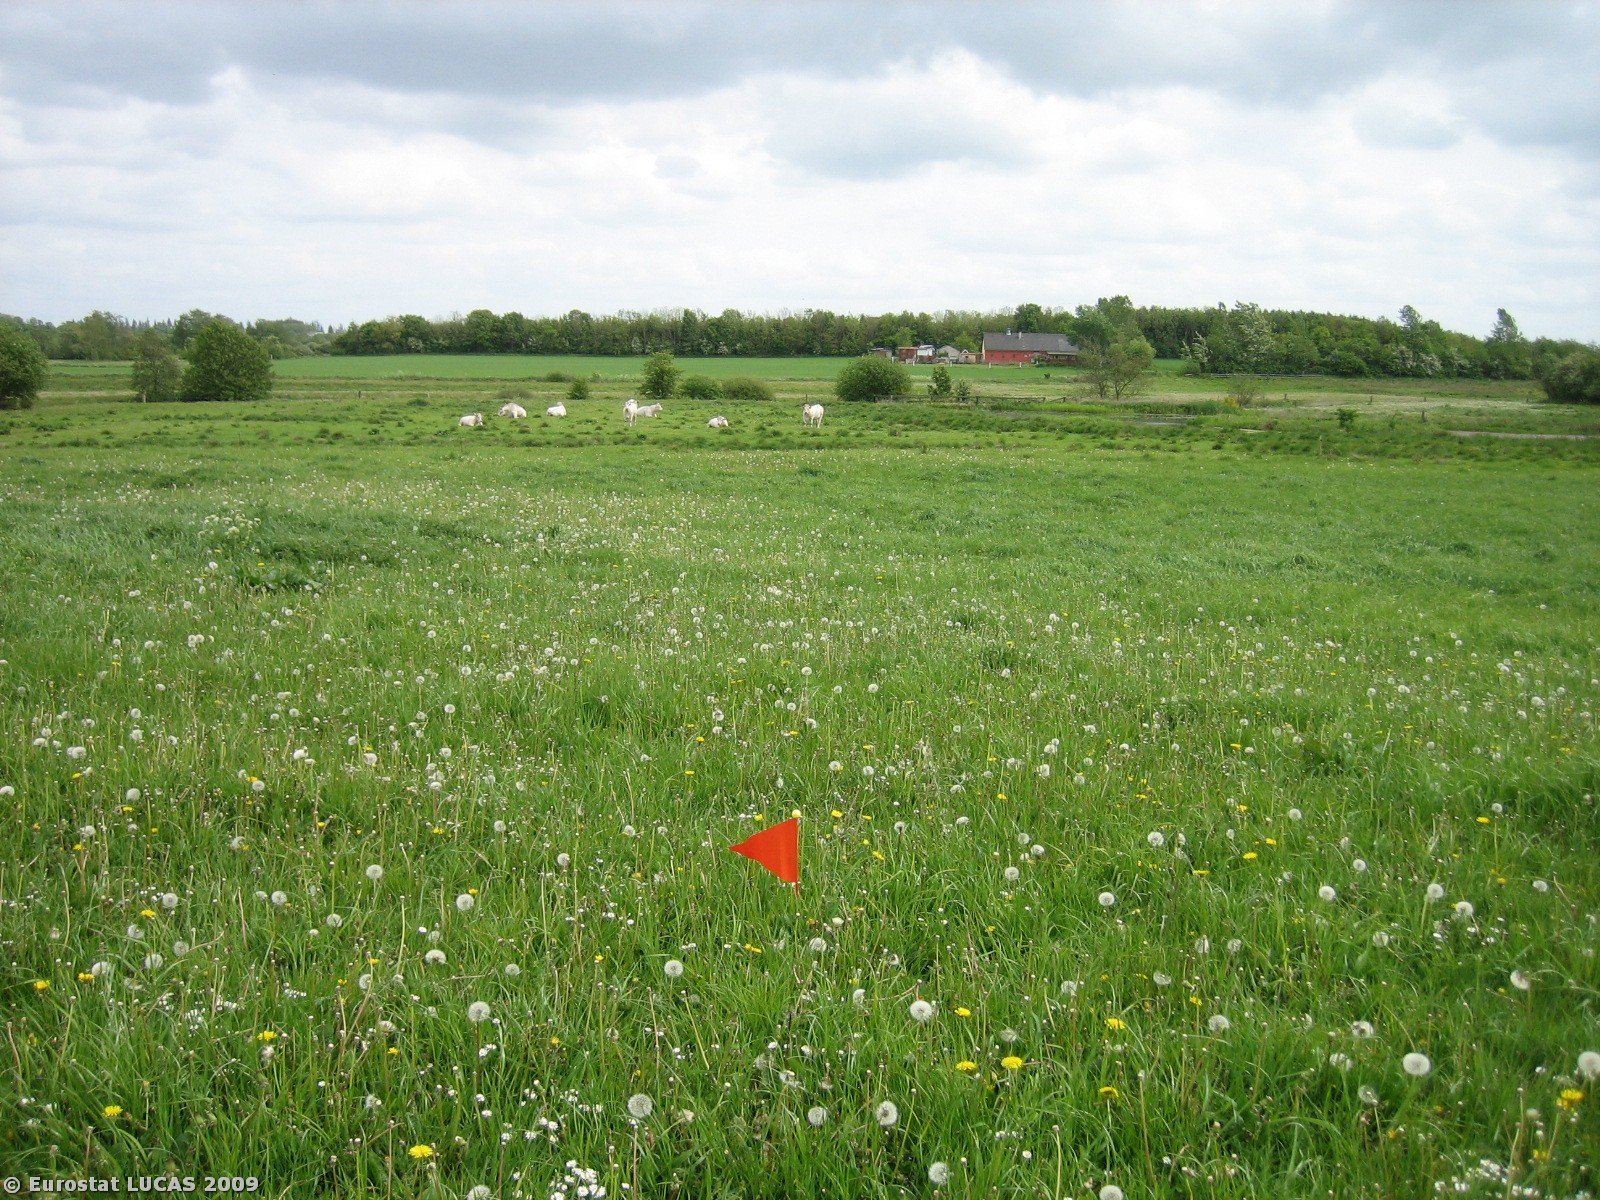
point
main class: Grassland
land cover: Grassland without tree/shrub cover
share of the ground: > 75 %
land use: Agriculture (excluding fallow land and kitchen gardens)
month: May
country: DK
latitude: 56.2186
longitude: 8.8564
